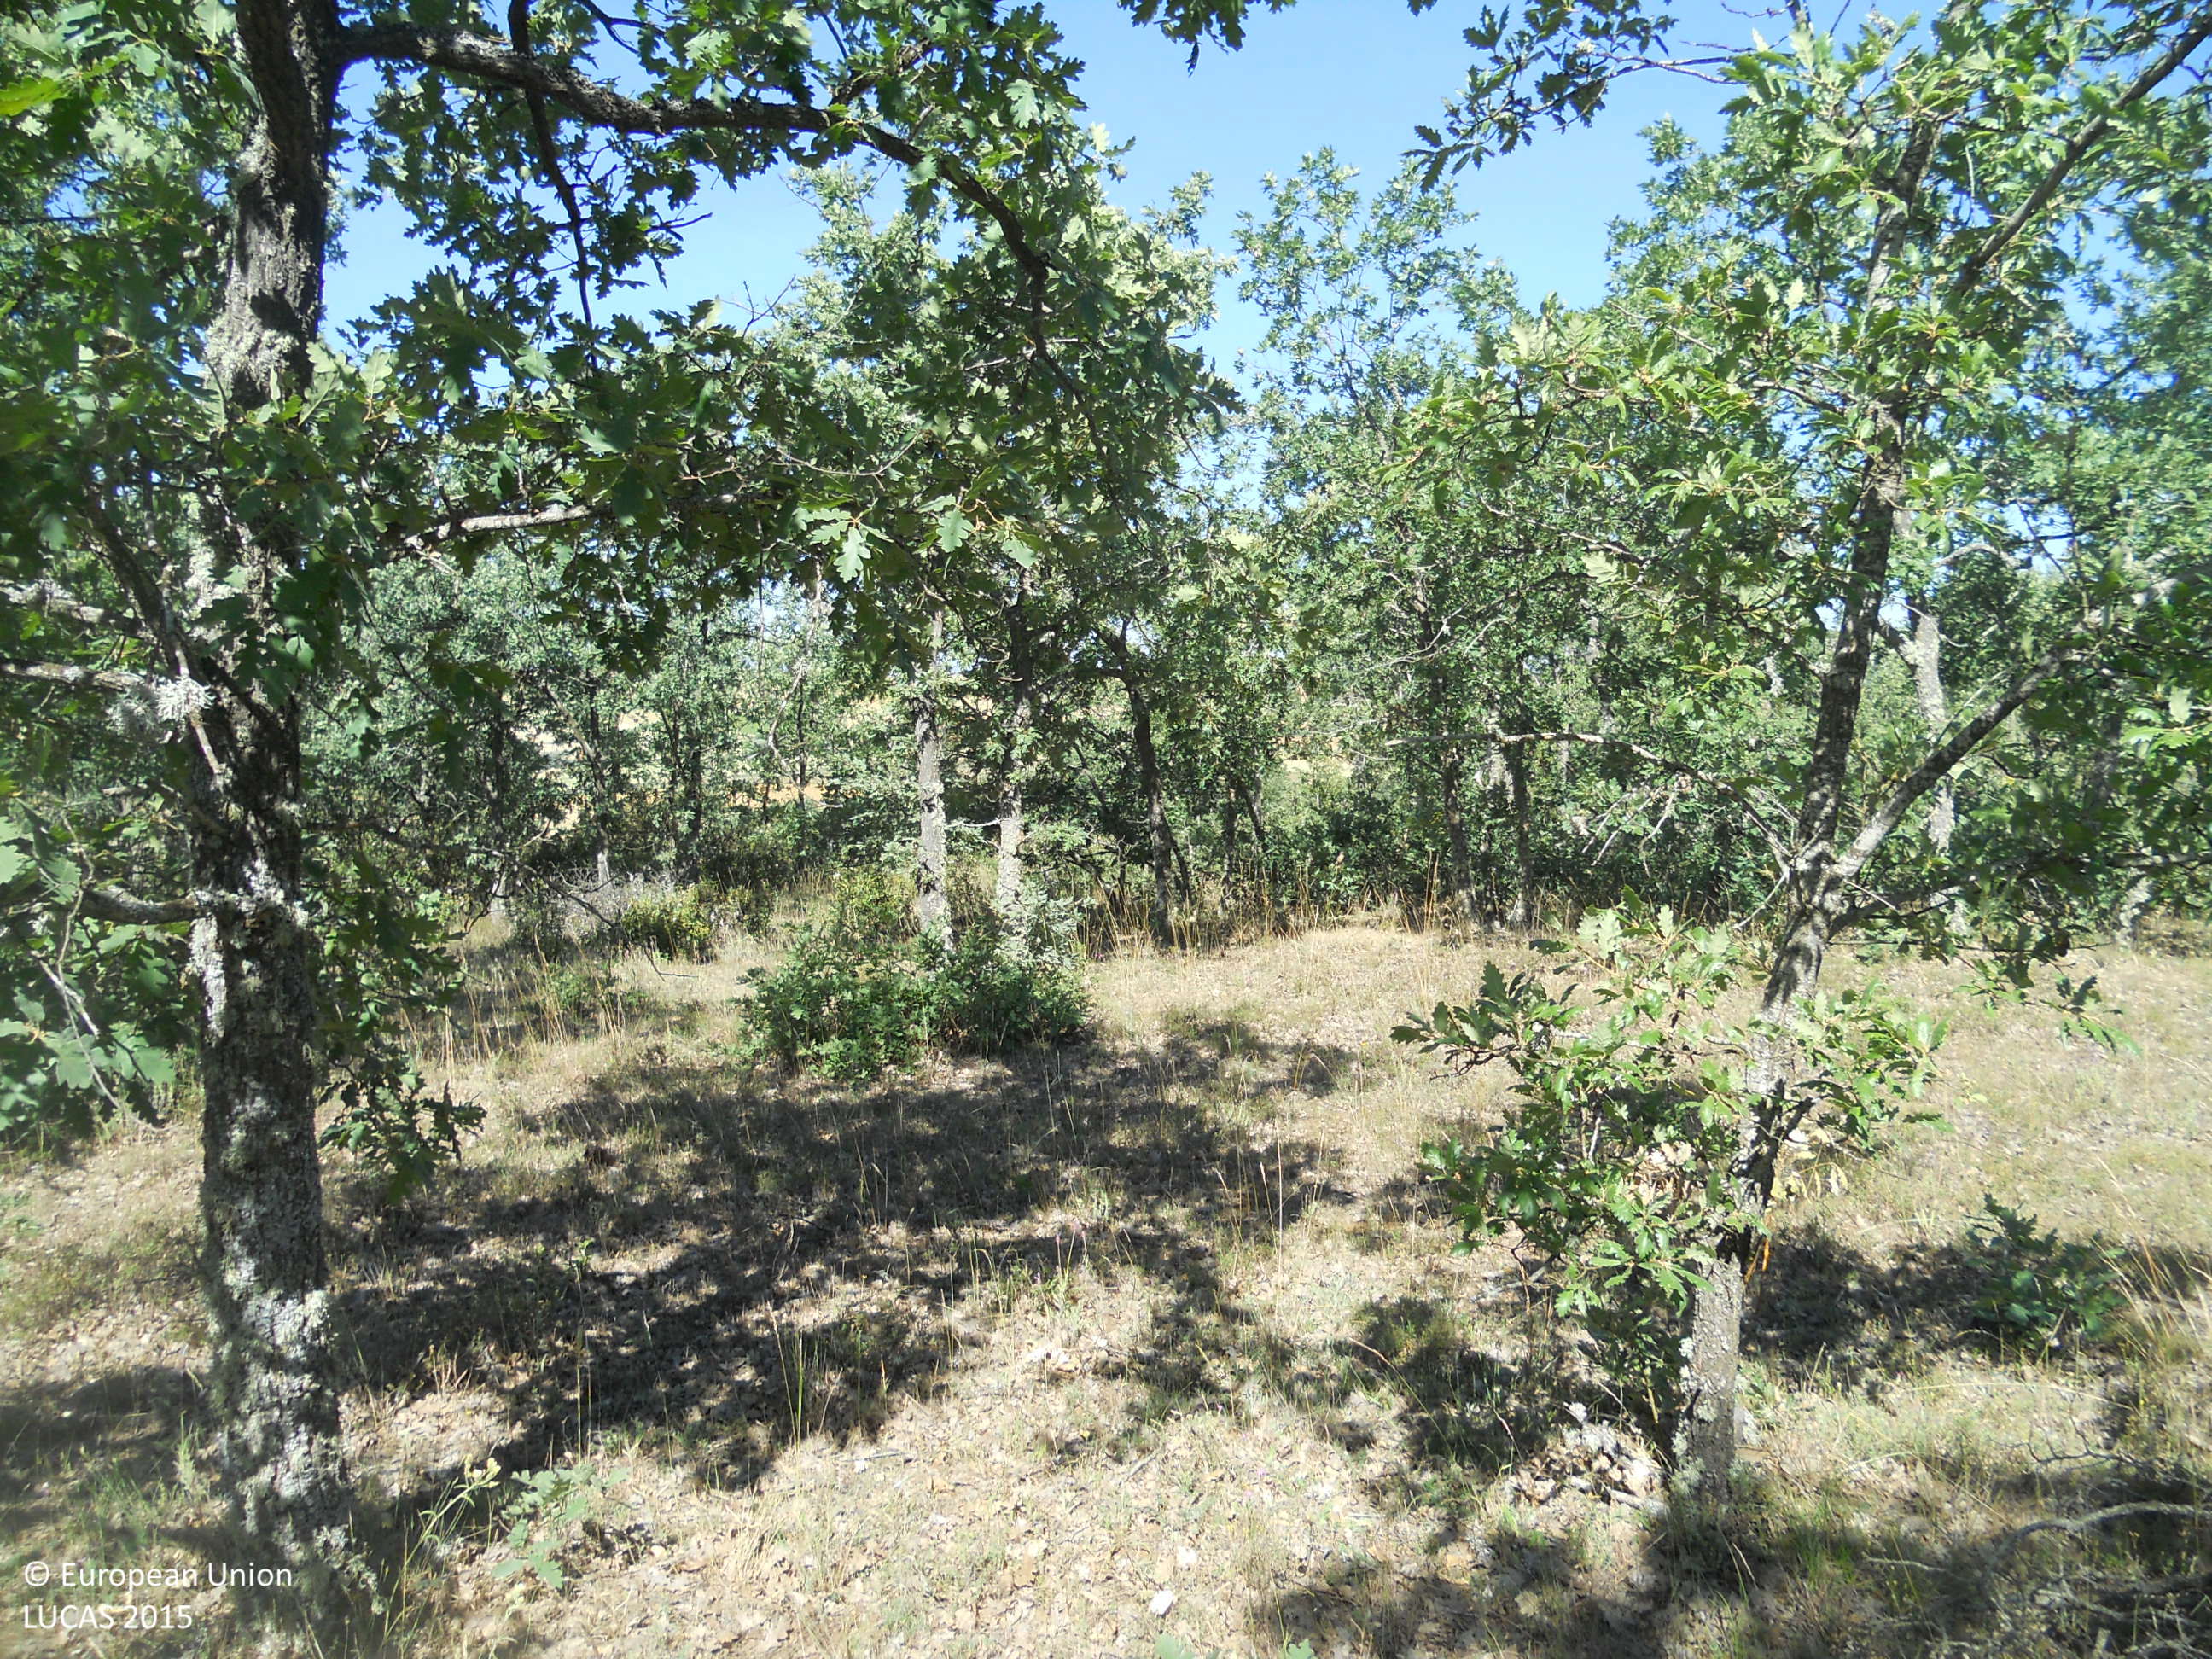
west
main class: Woodland
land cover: Broadleaved woodland
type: thermophilous deciduous forest
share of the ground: 50 - 75 %
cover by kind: herbaceous plants 55 %, broadleaved forest trees 45 %
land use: Forestry
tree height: > 5 m
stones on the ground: > 50 %
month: June
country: ES
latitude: 42.3898
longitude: -4.8886
